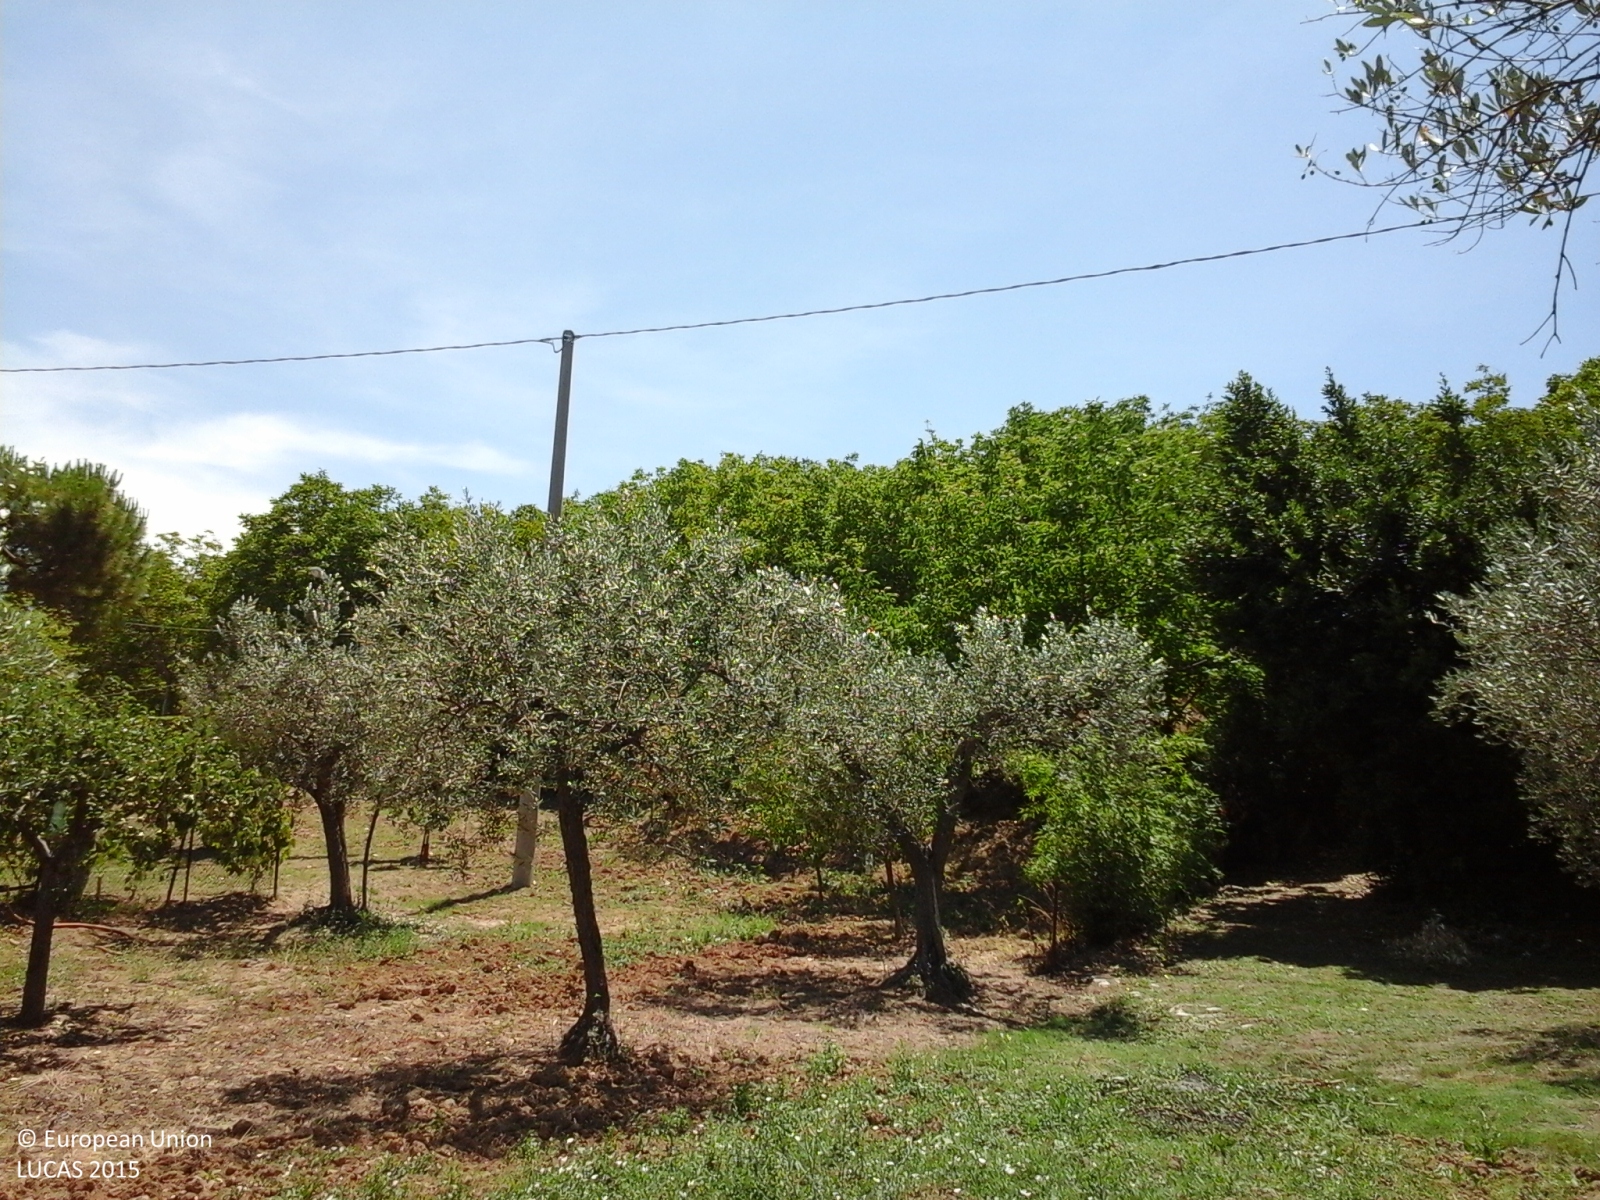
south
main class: Cropland
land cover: Olive groves
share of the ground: 25 - 50 %
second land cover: Other fresh vegetables
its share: 25 - 50 %
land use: Agriculture (excluding fallow land and kitchen gardens)
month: June
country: IT
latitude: 42.2345
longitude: 14.3610
